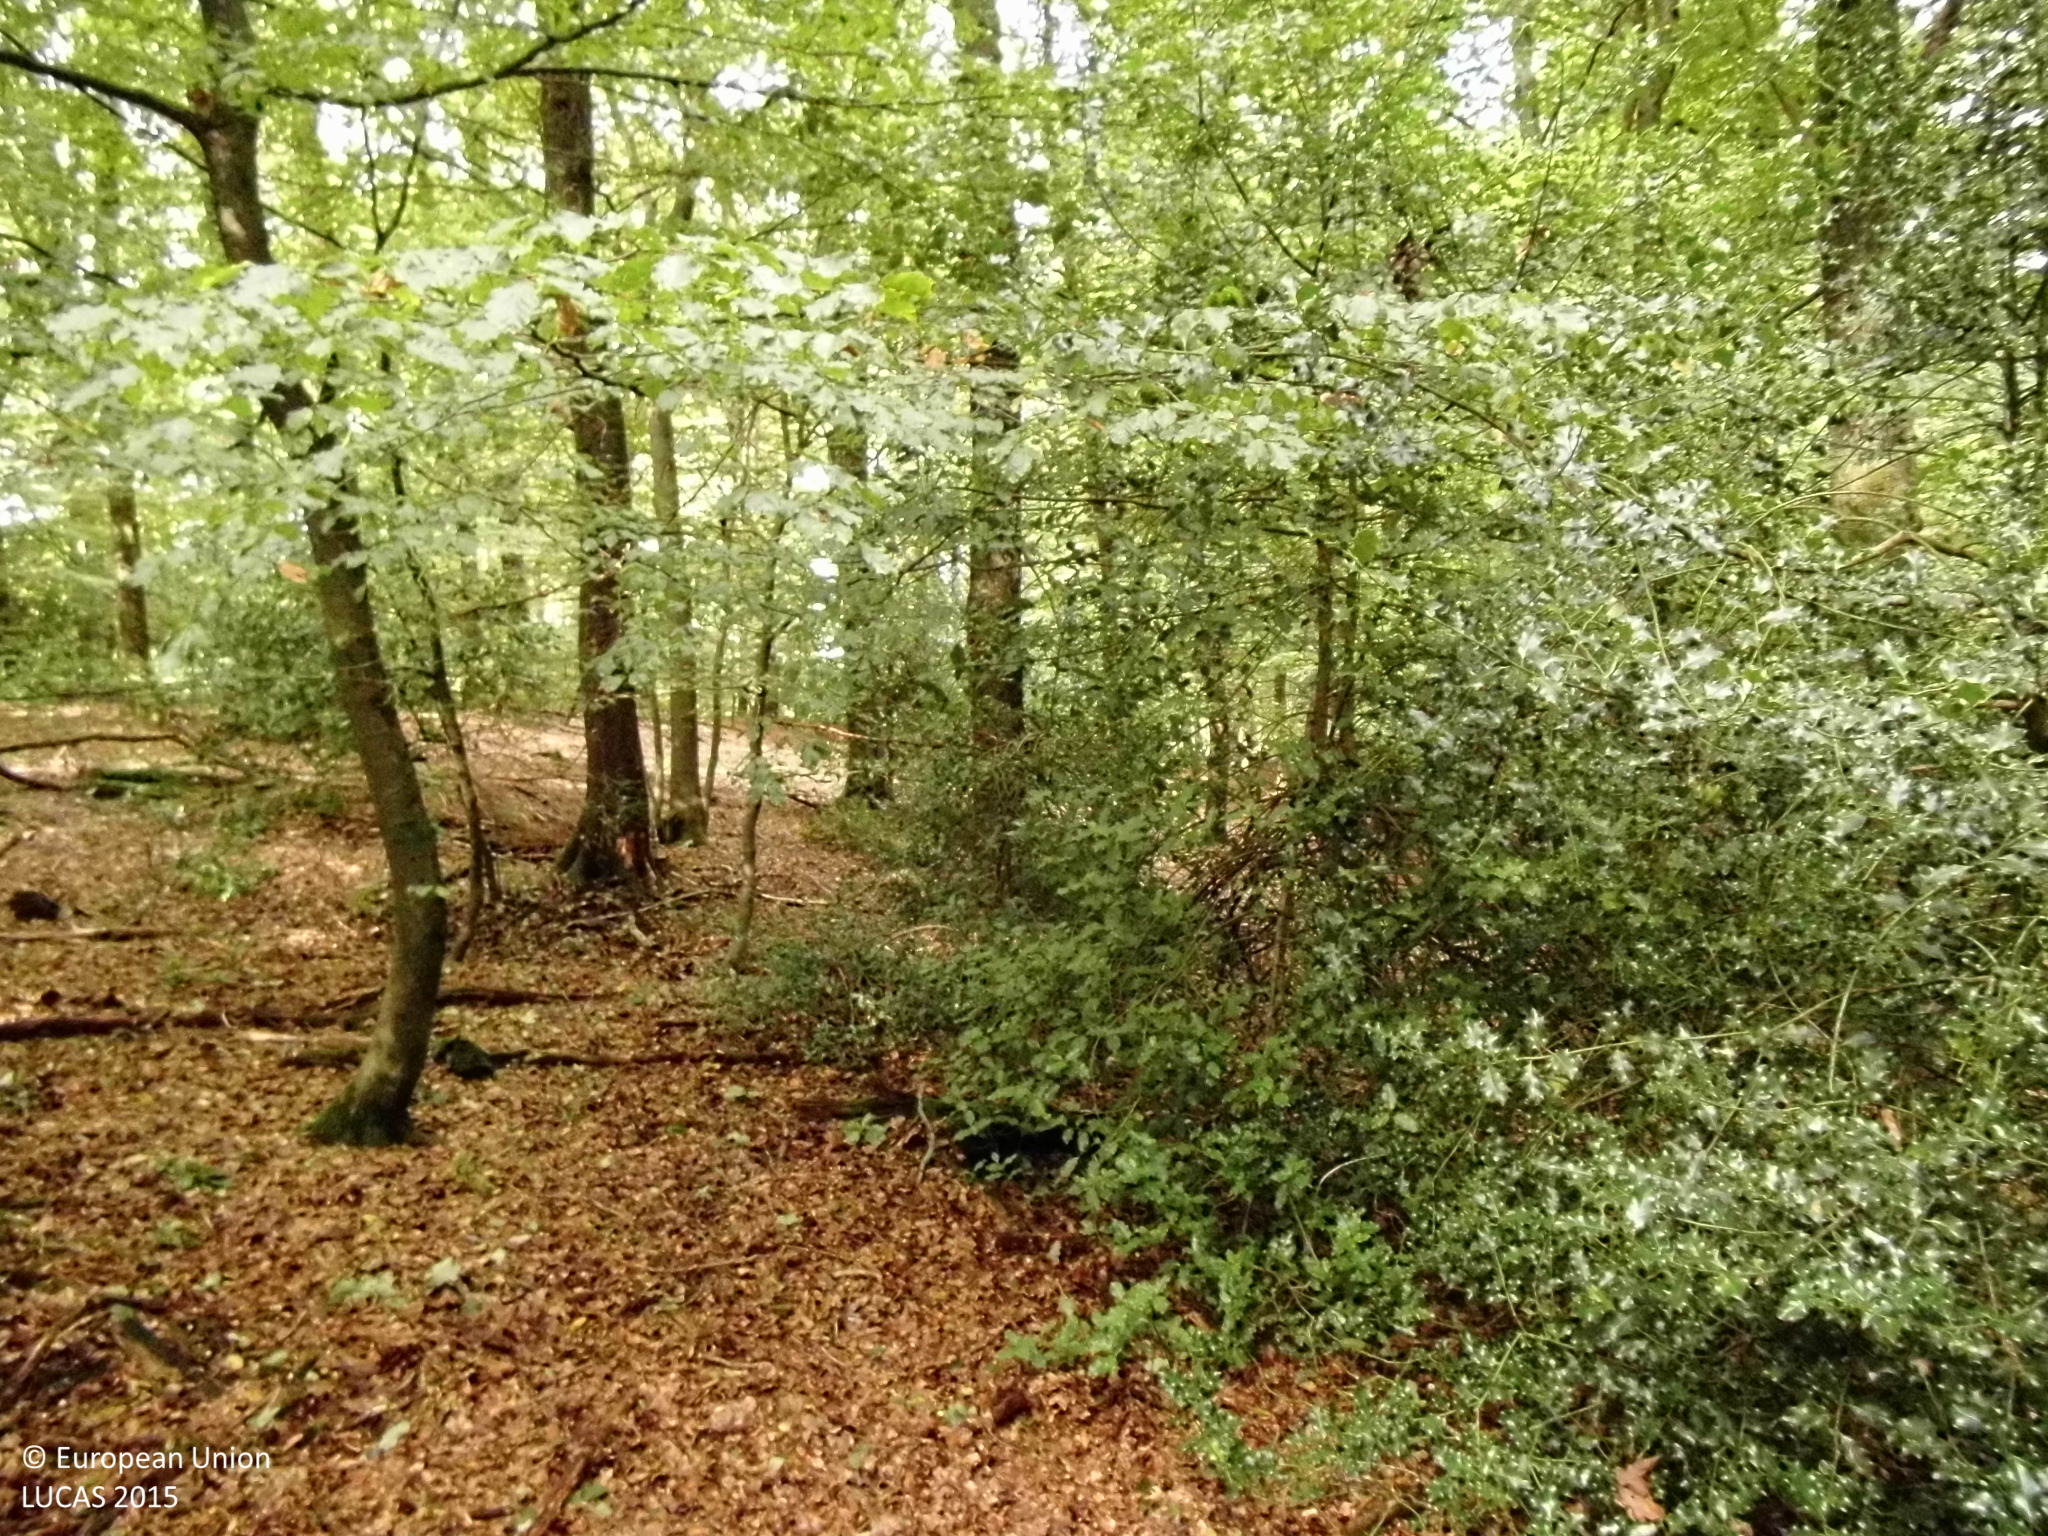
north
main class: Woodland
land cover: Broadleaved woodland
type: mesophytic deciduous forest
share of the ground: > 75 %
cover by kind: broadleaved forest trees 100 %
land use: Forestry
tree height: > 5 m
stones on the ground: < 10 %
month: September
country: DE
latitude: 51.0923
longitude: 7.5016
